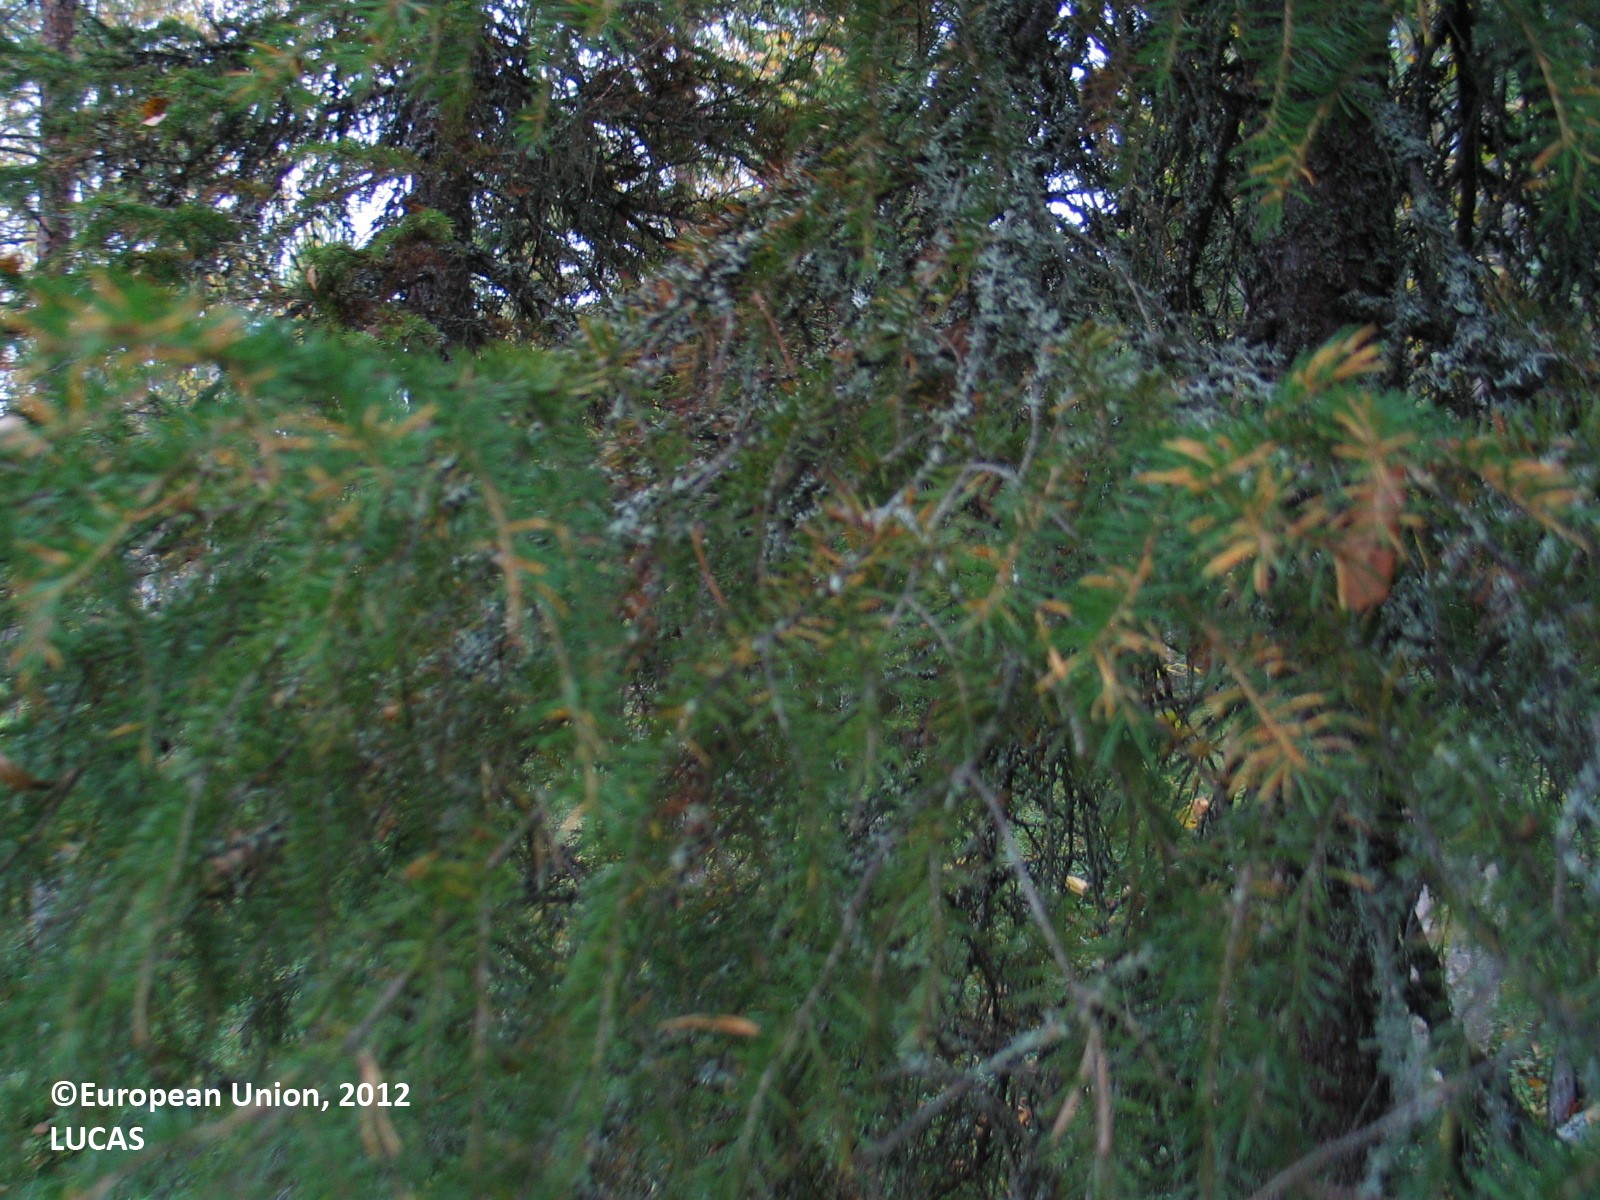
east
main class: Woodland
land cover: Other mixed woodland
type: boreal forest
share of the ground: 50 - 75 %
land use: Forestry
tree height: > 5 m
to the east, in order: Other mixed woodland; Pine dominated mixed woodland; Pine dominated coniferous woodland
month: September
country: FI
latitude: 65.4795
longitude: 25.6948
